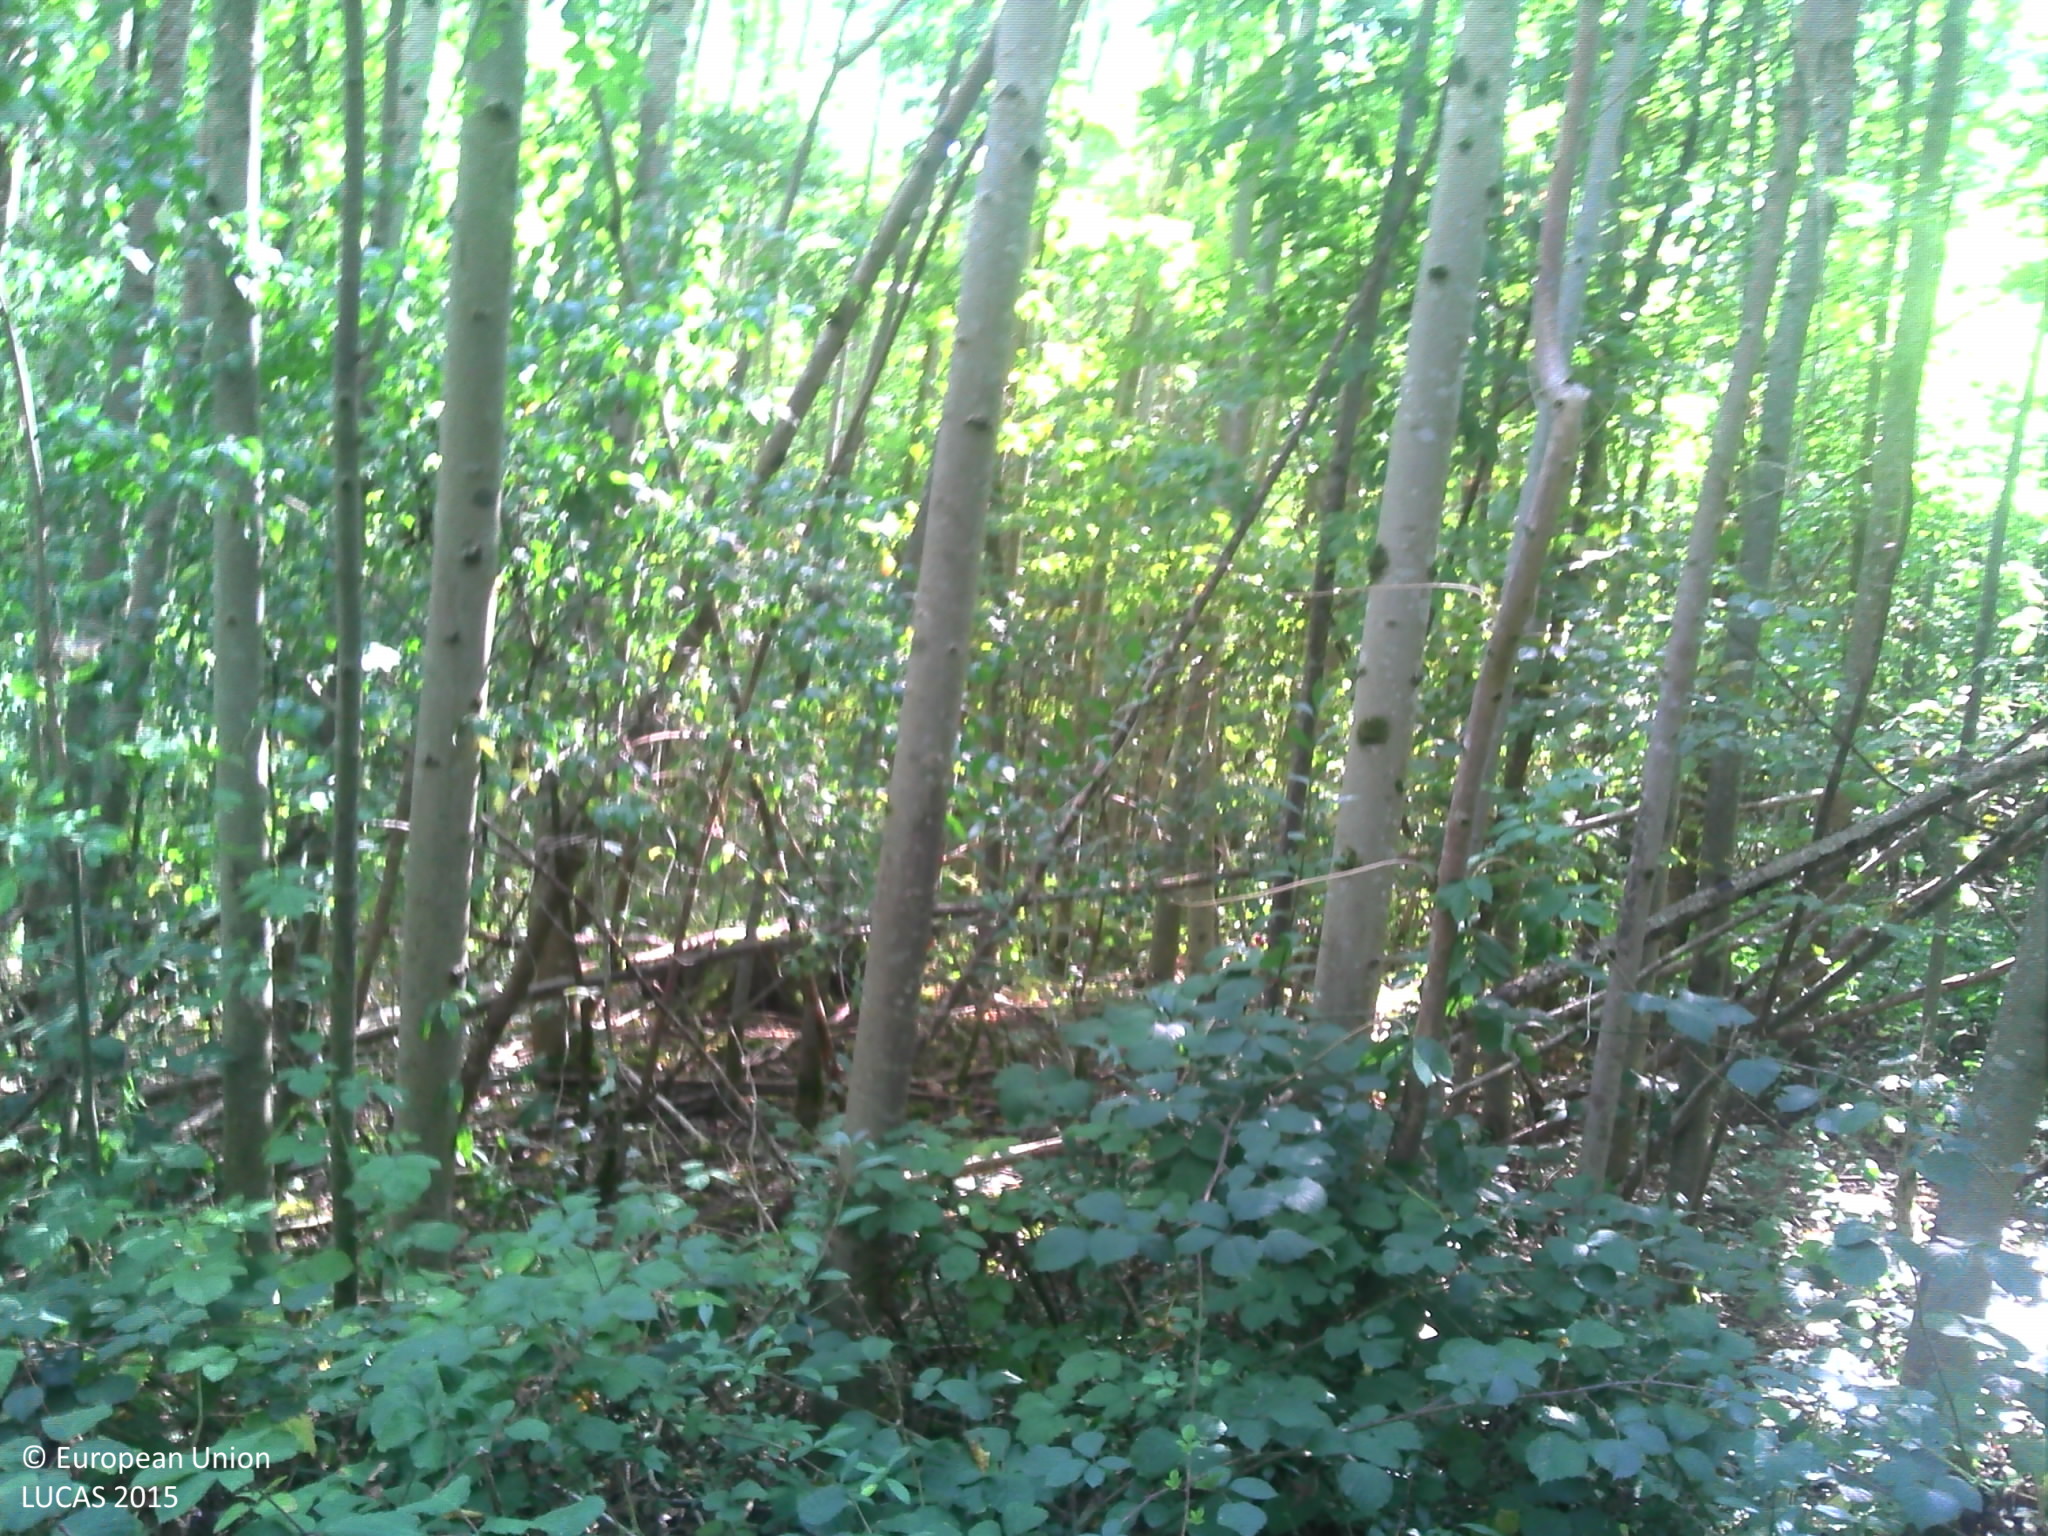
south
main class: Woodland
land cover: Broadleaved woodland
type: mesophytic deciduous forest
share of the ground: > 75 %
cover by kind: broadleaved forest trees 85 %, herbaceous plants 10 %, consolidated bare surface 5 %
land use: Forestry
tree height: > 5 m
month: September
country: FR
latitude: 48.8093
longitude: 6.2826
